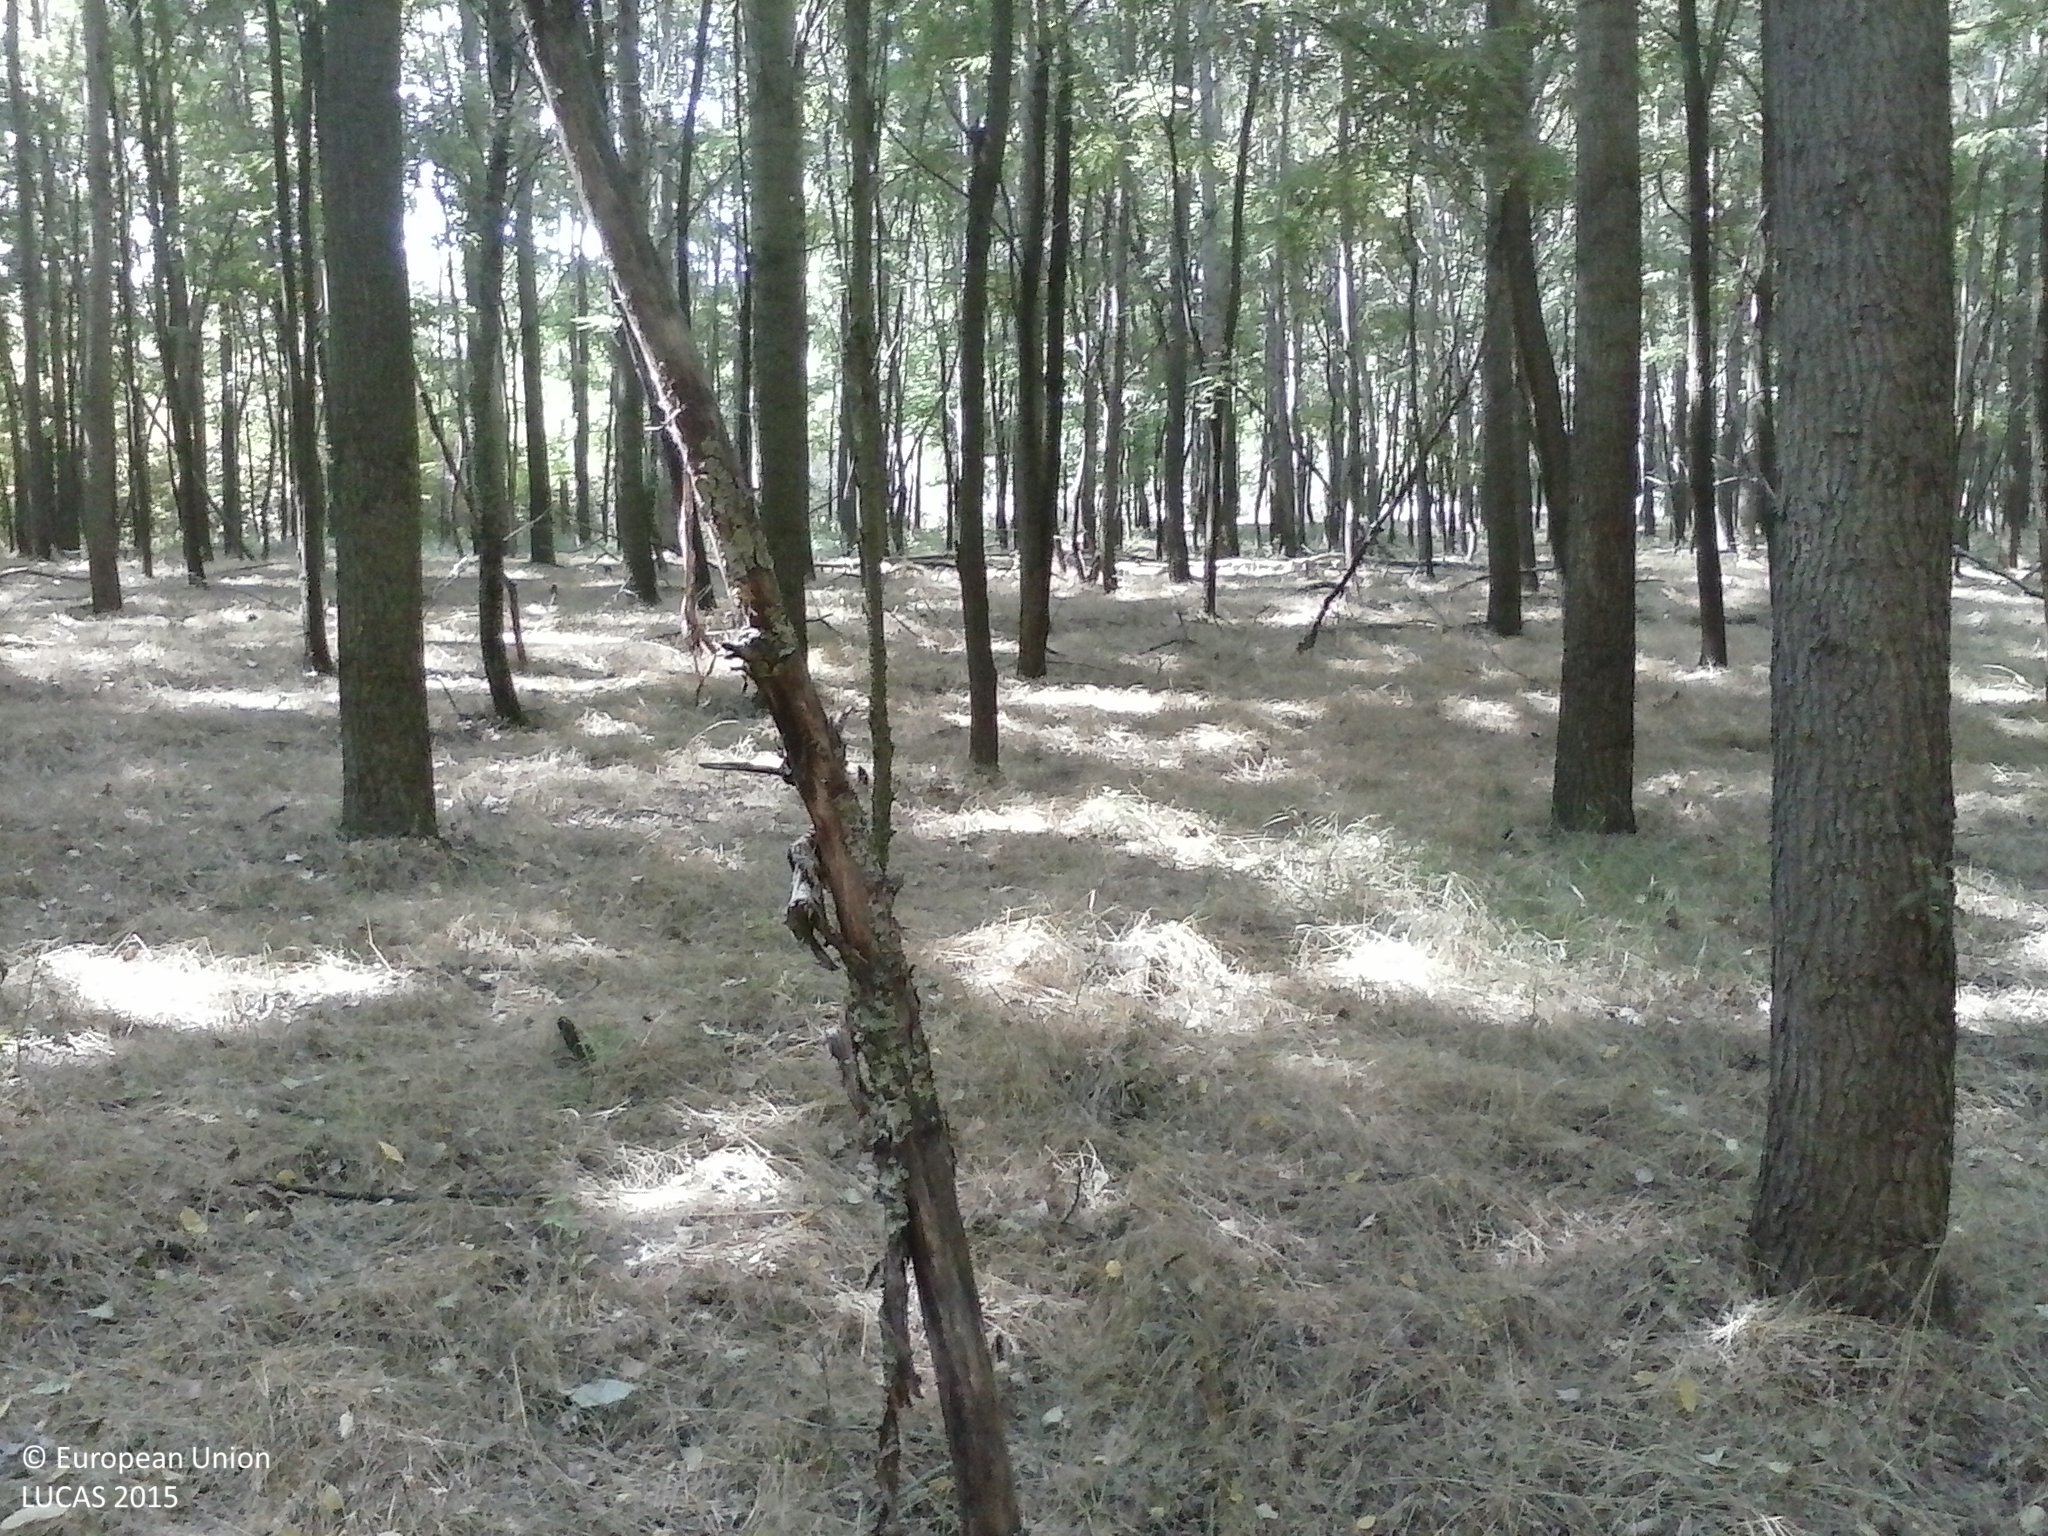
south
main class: Woodland
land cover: Broadleaved woodland
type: mesophytic deciduous forest
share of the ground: > 75 %
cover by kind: broadleaved forest trees 90 %, herbaceous plants 10 %
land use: Forestry
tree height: > 5 m
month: July
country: HU
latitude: 46.4945
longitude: 19.6470
